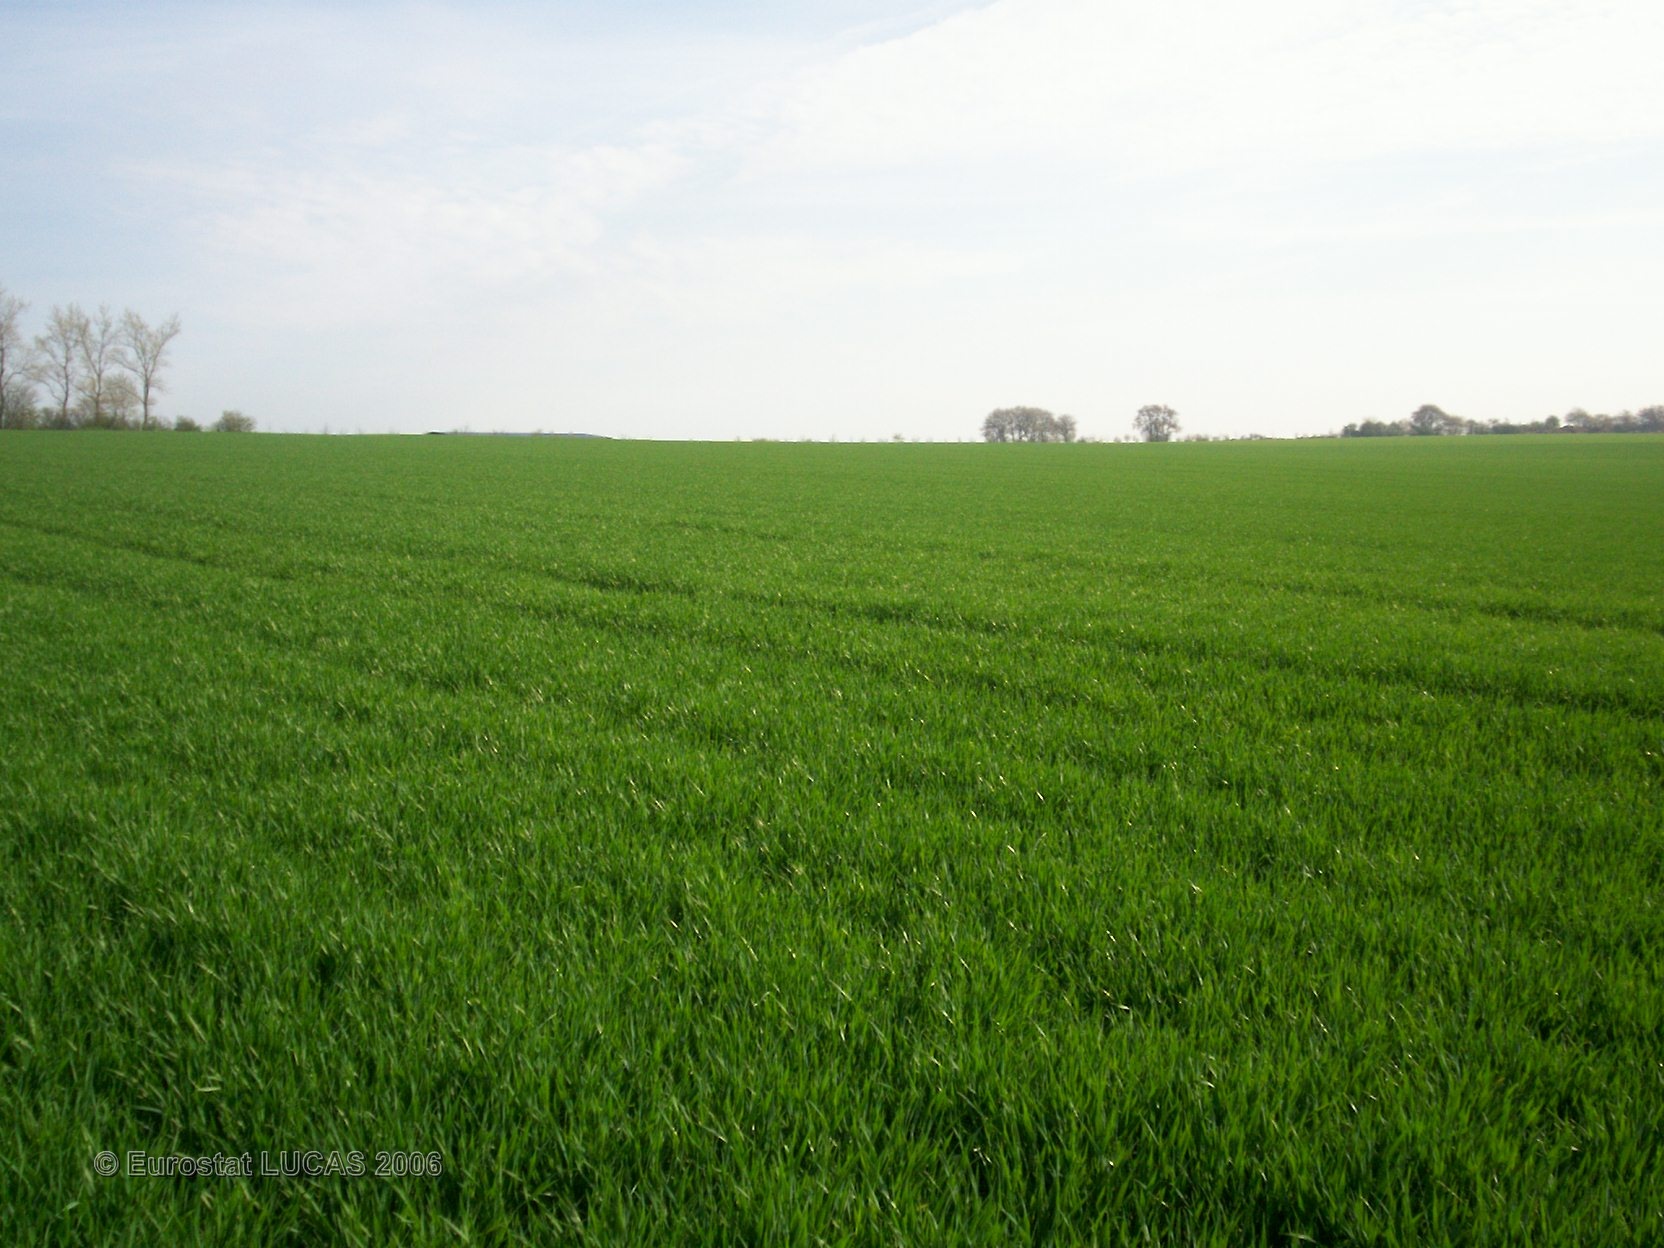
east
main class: Cropland
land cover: Barley
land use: Agriculture (excluding fallow land and kitchen gardens)
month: April
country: FR
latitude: 48.9057
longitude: 5.9476
